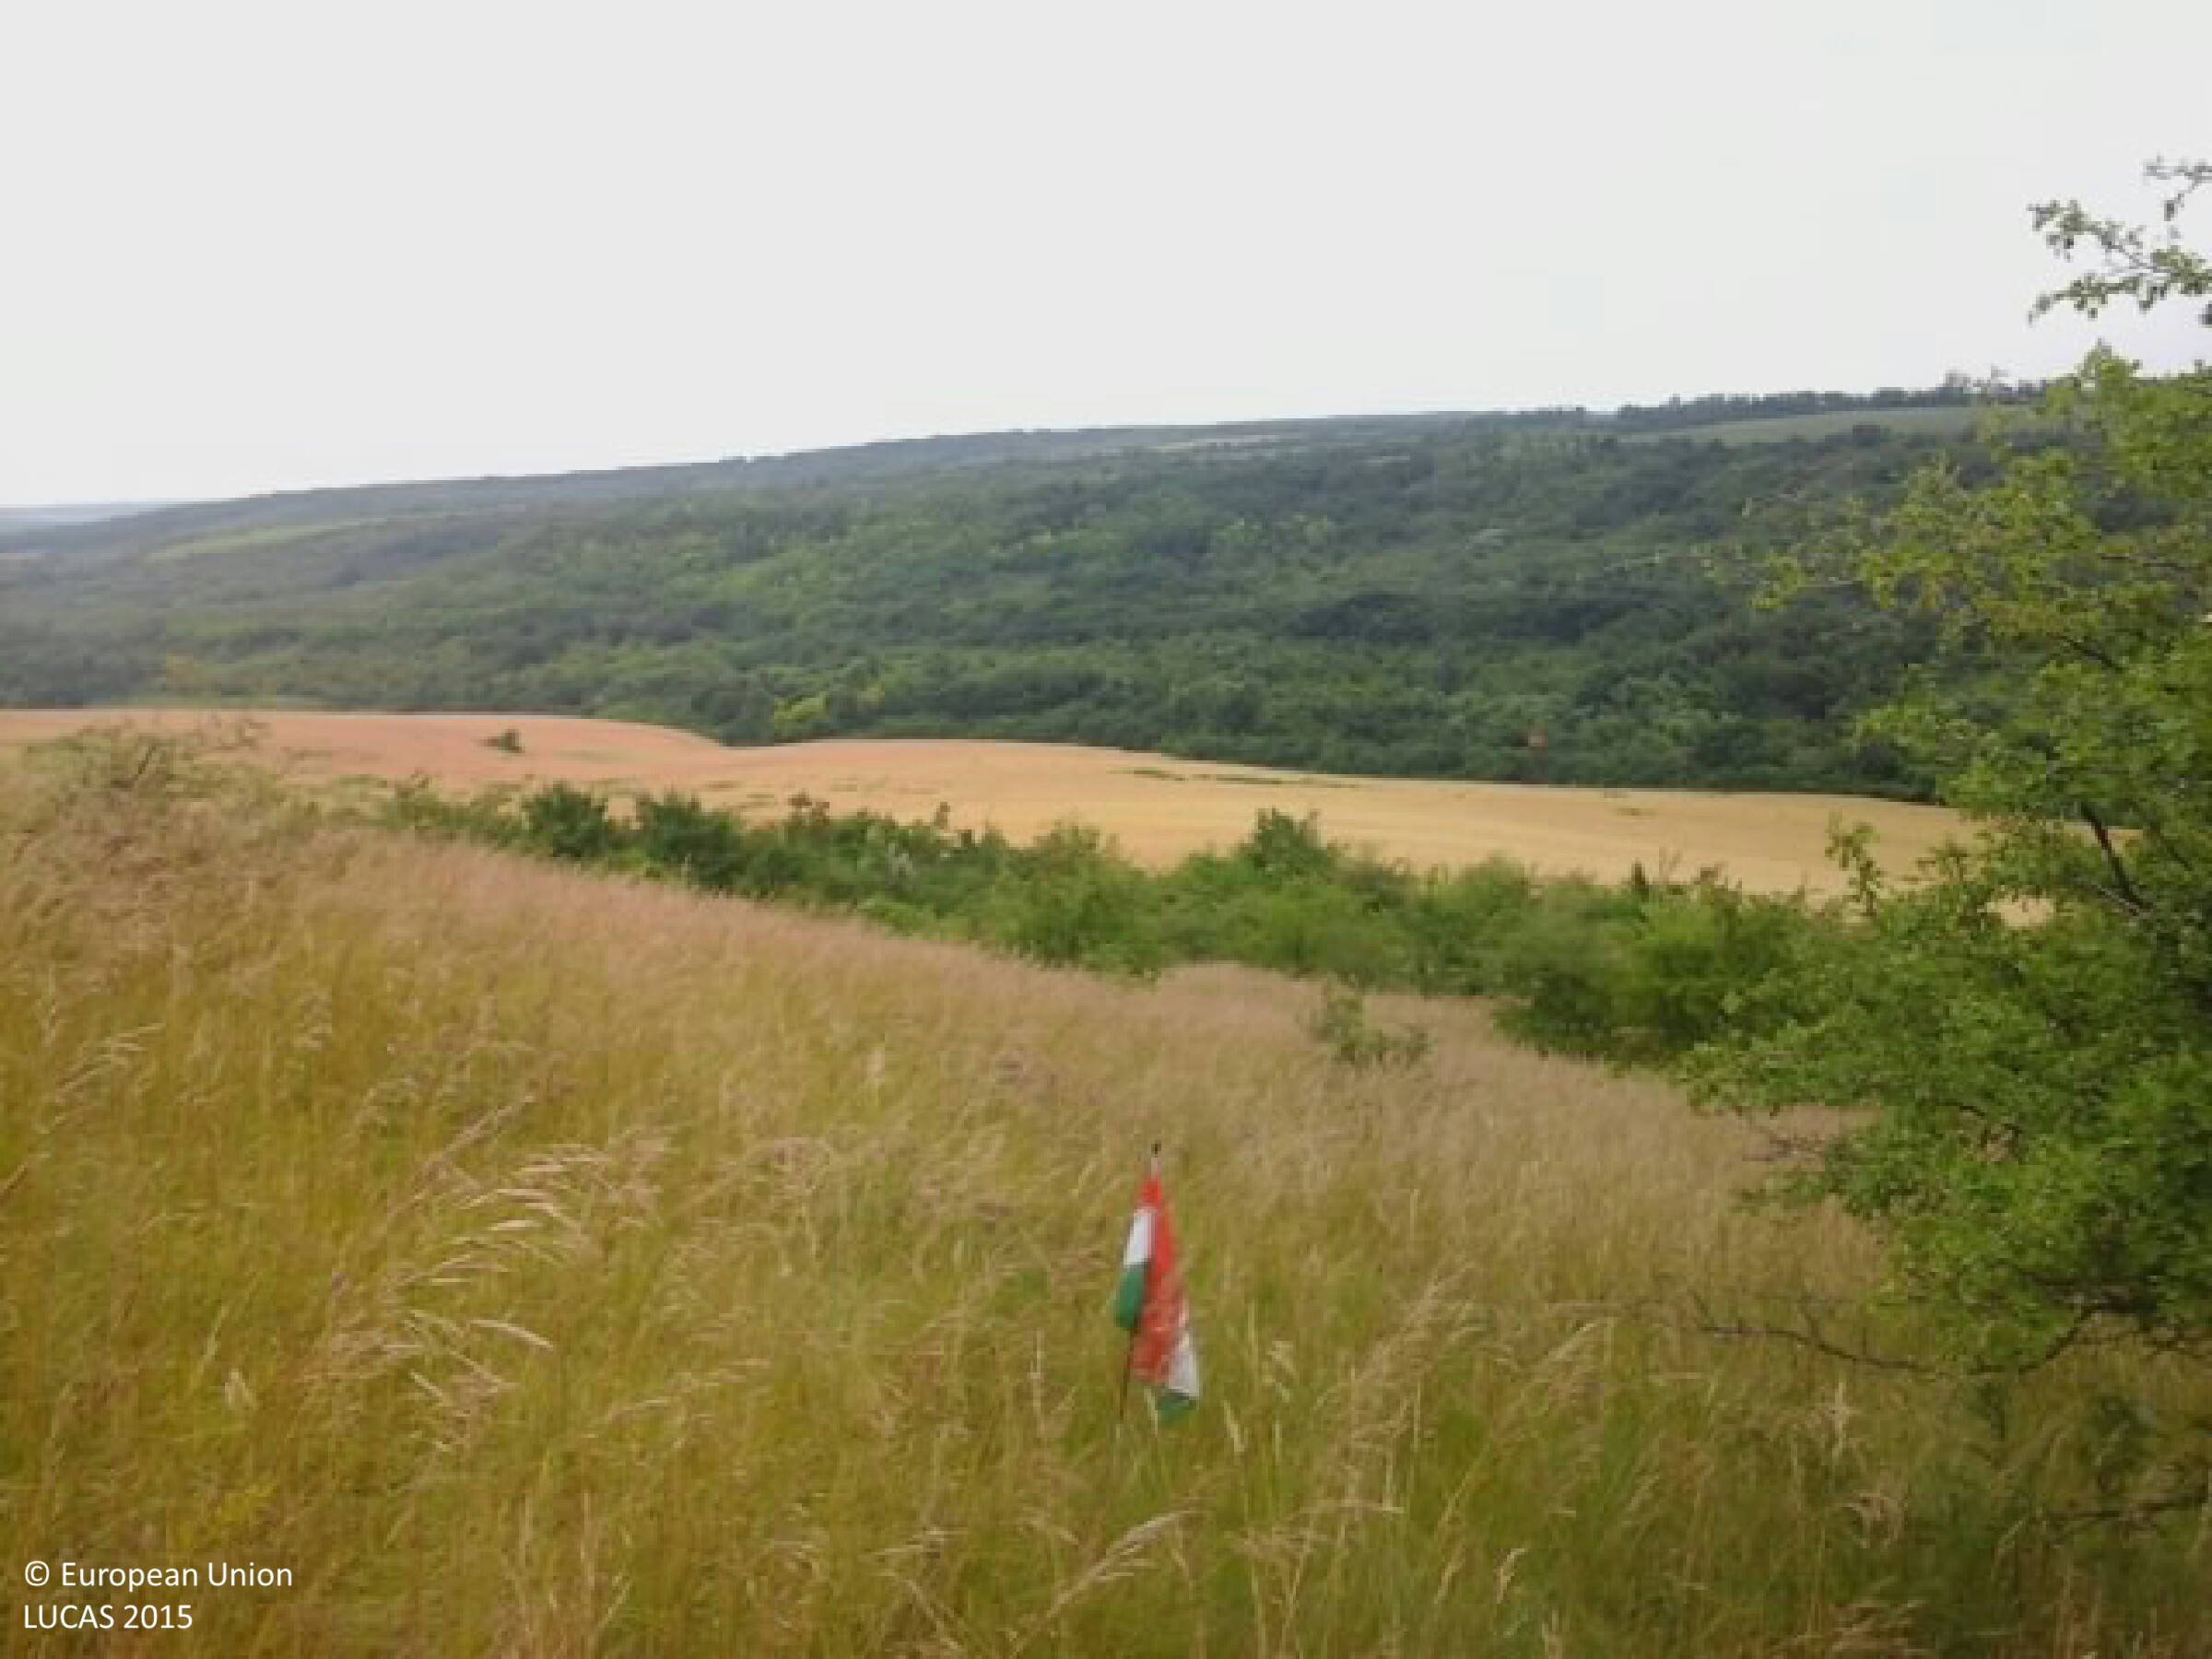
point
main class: Woodland
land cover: Broadleaved woodland
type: mesophytic deciduous forest
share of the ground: 25 - 50 %
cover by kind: herbaceous plants 50 %, broadleaved forest trees 40 %, shrubs 10 %
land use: Semi-natural and natural areas not in use
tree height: > 5 m
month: June
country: HU
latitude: 47.4767
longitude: 19.4020
